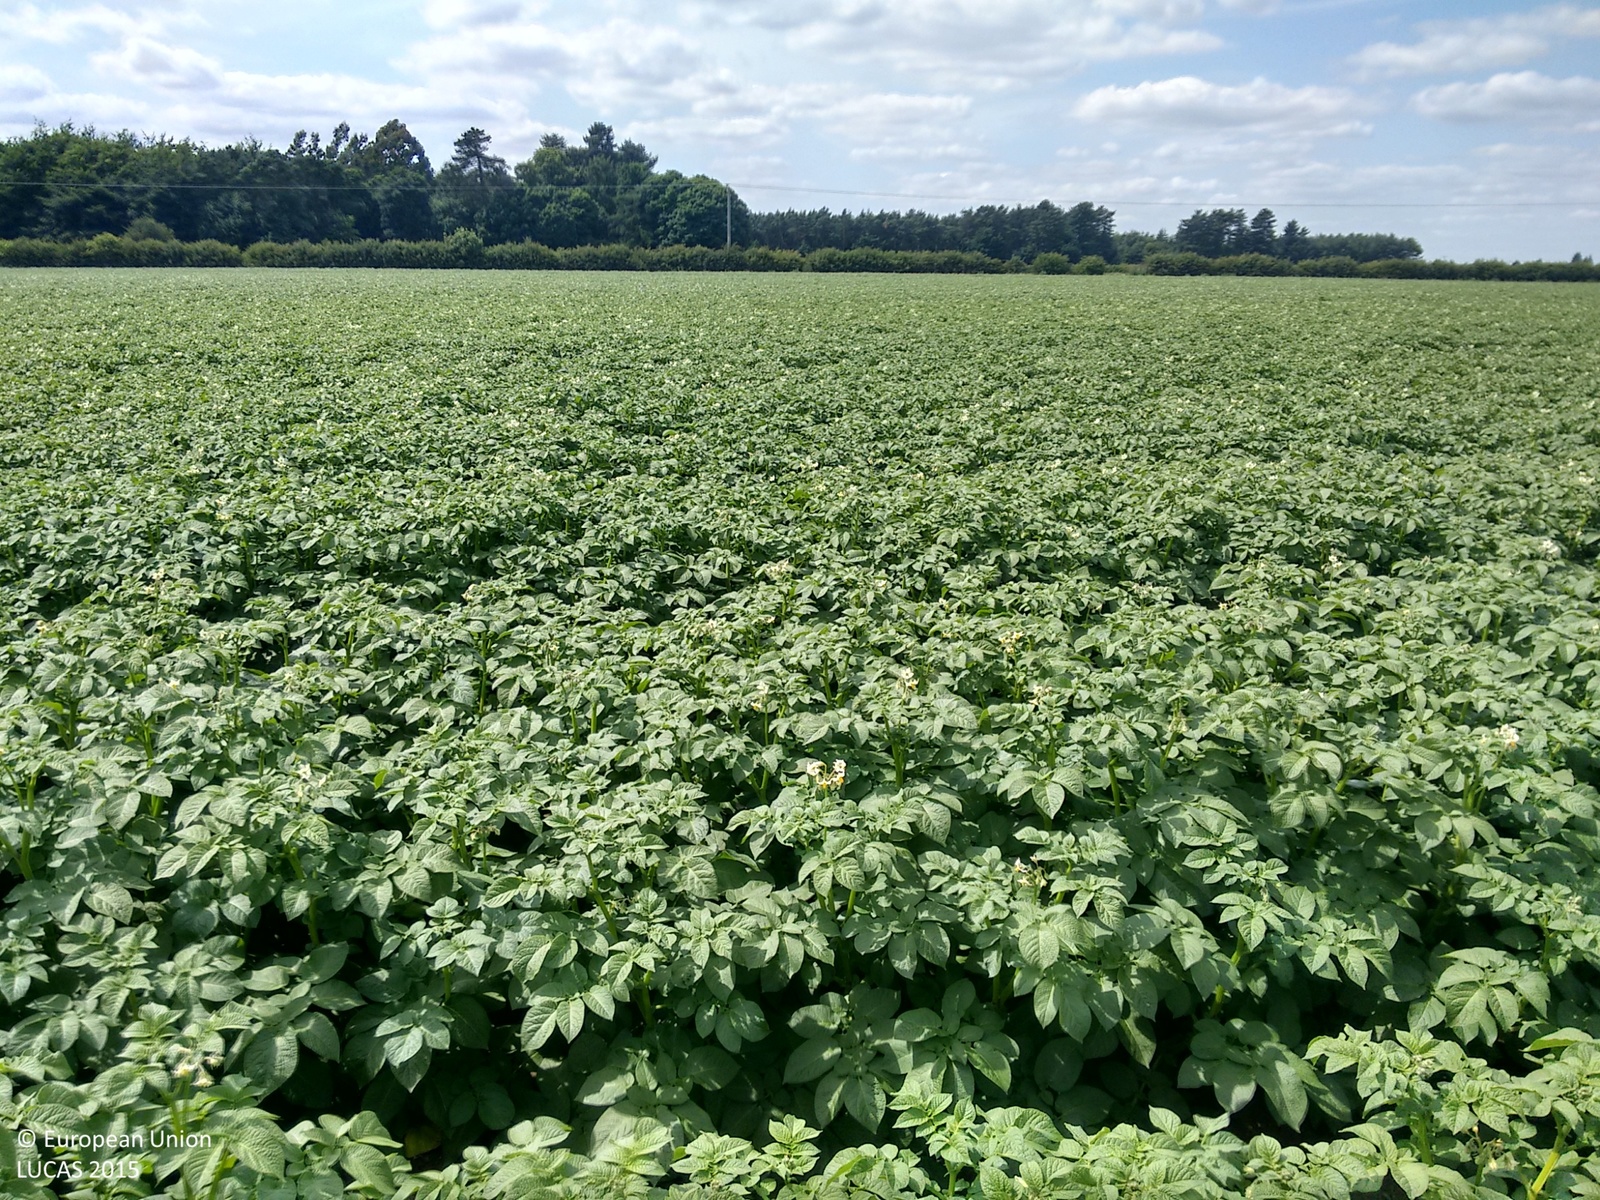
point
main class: Cropland
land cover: Potatoes
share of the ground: > 75 %
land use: Agriculture (excluding fallow land and kitchen gardens)
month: July
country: GB
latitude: 53.3151
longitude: -1.0162
